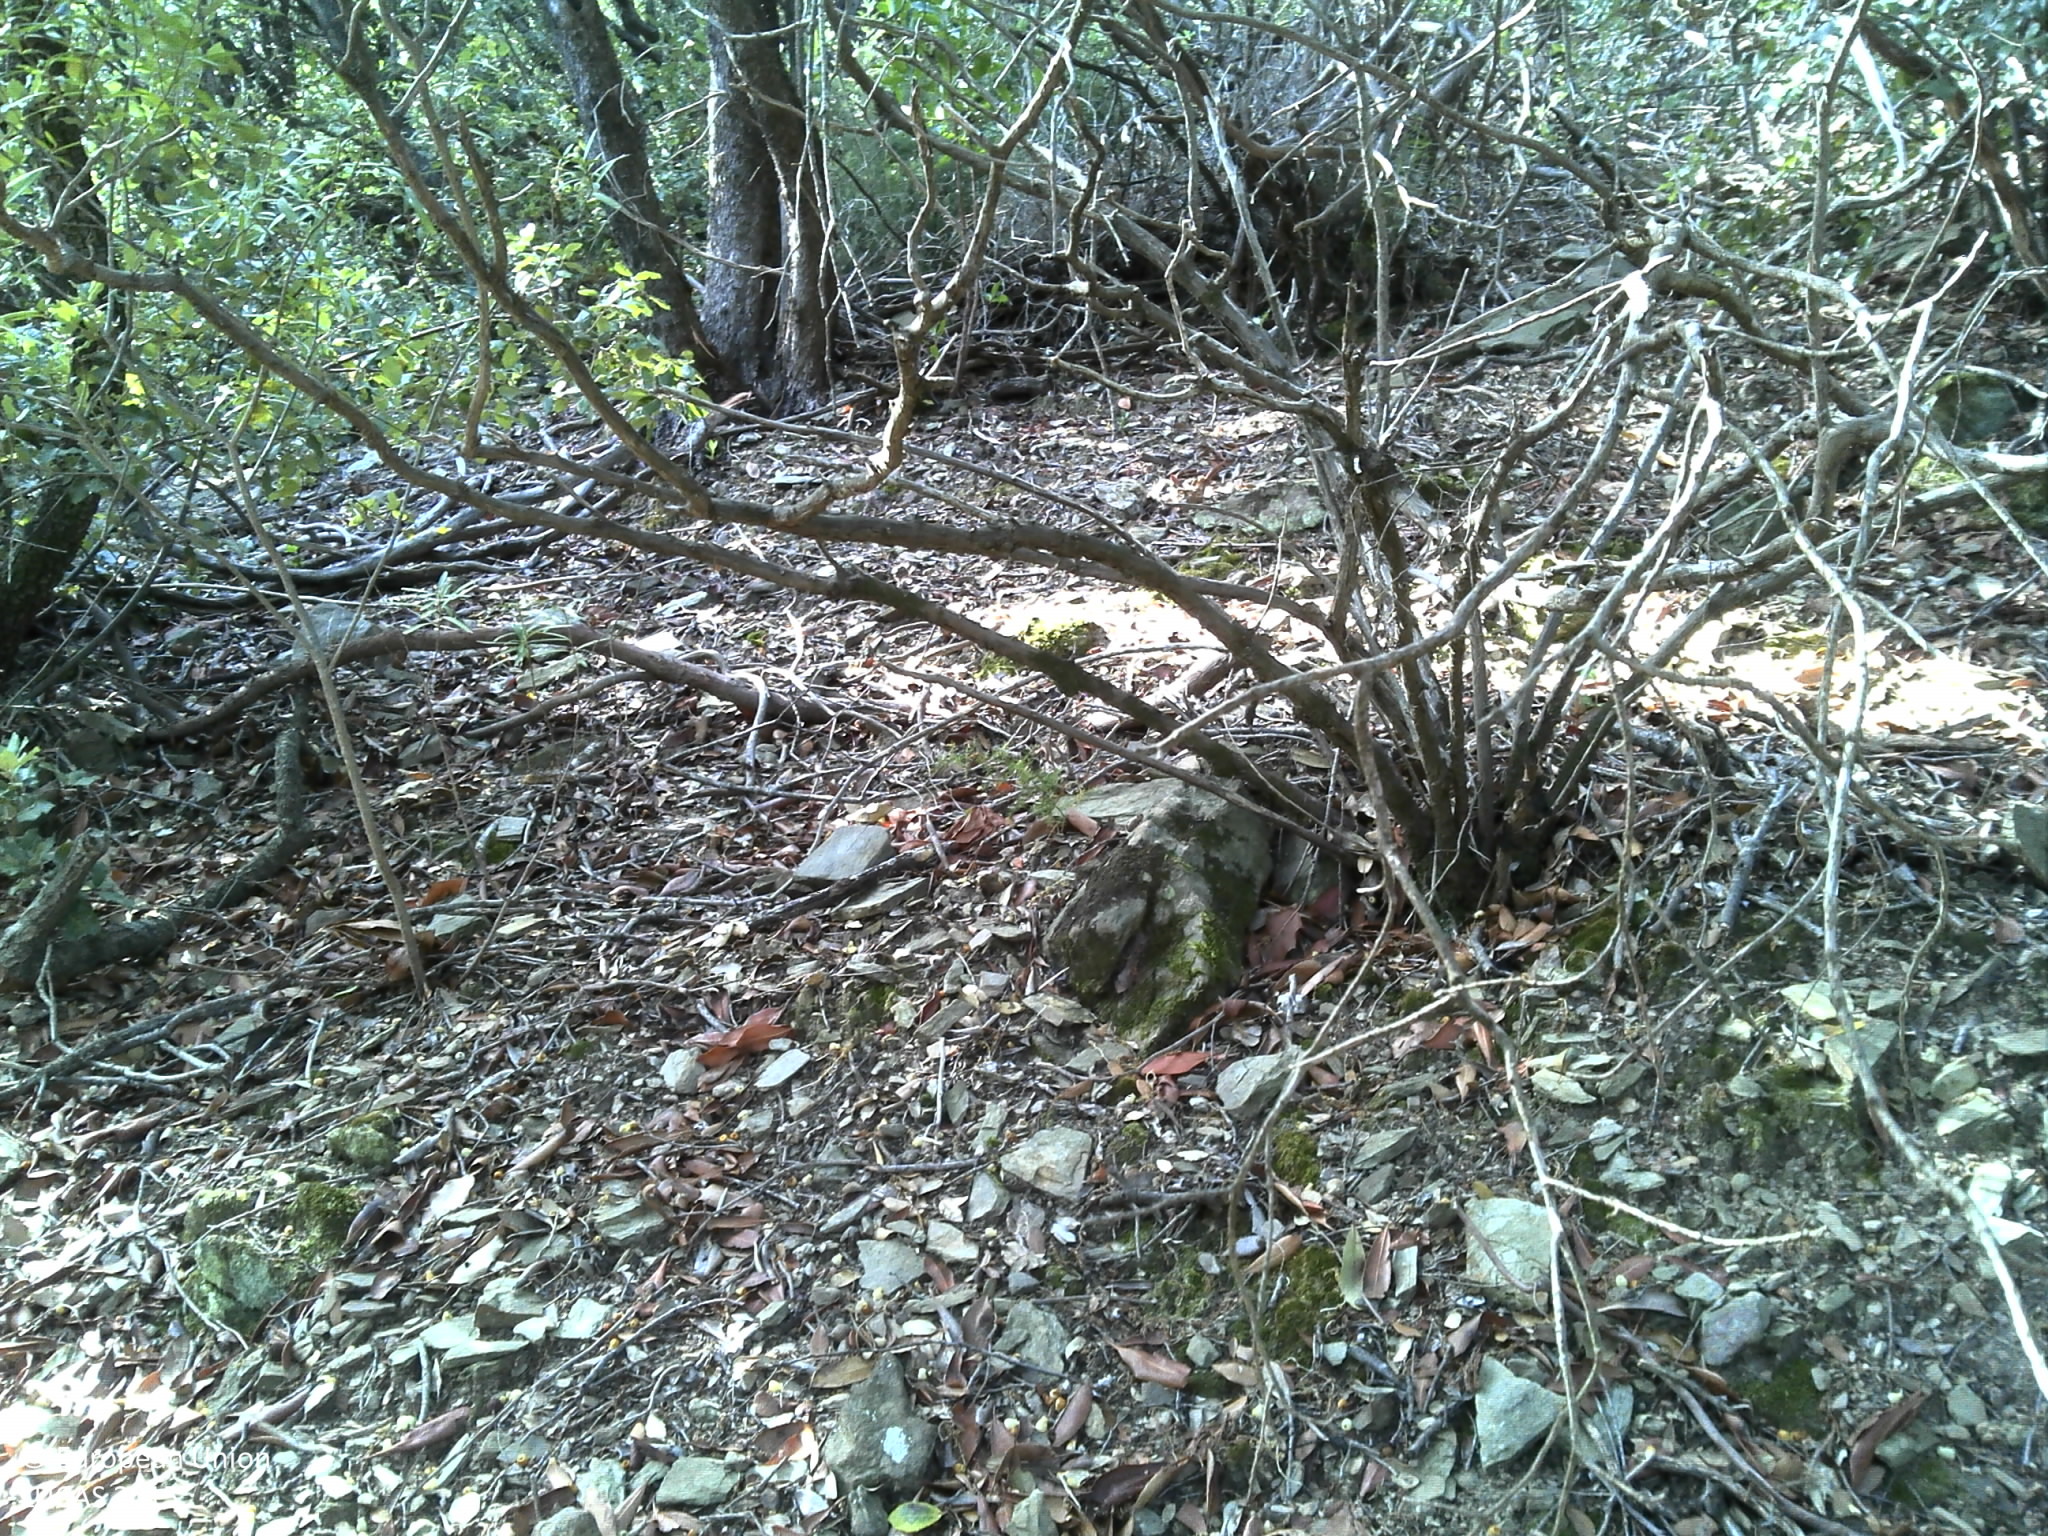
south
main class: Woodland
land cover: Broadleaved woodland
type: broadleaved evergreen forest
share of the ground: 50 - 75 %
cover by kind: broadleaved forest trees 70 %, consolidated bare surface 15 %, coniferous forest trees 5 %, shrubs 5 %, herbaceous plants 5 %
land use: Semi-natural and natural areas not in use
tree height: > 5 m
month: October
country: FR
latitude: 43.5475
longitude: 3.1886
